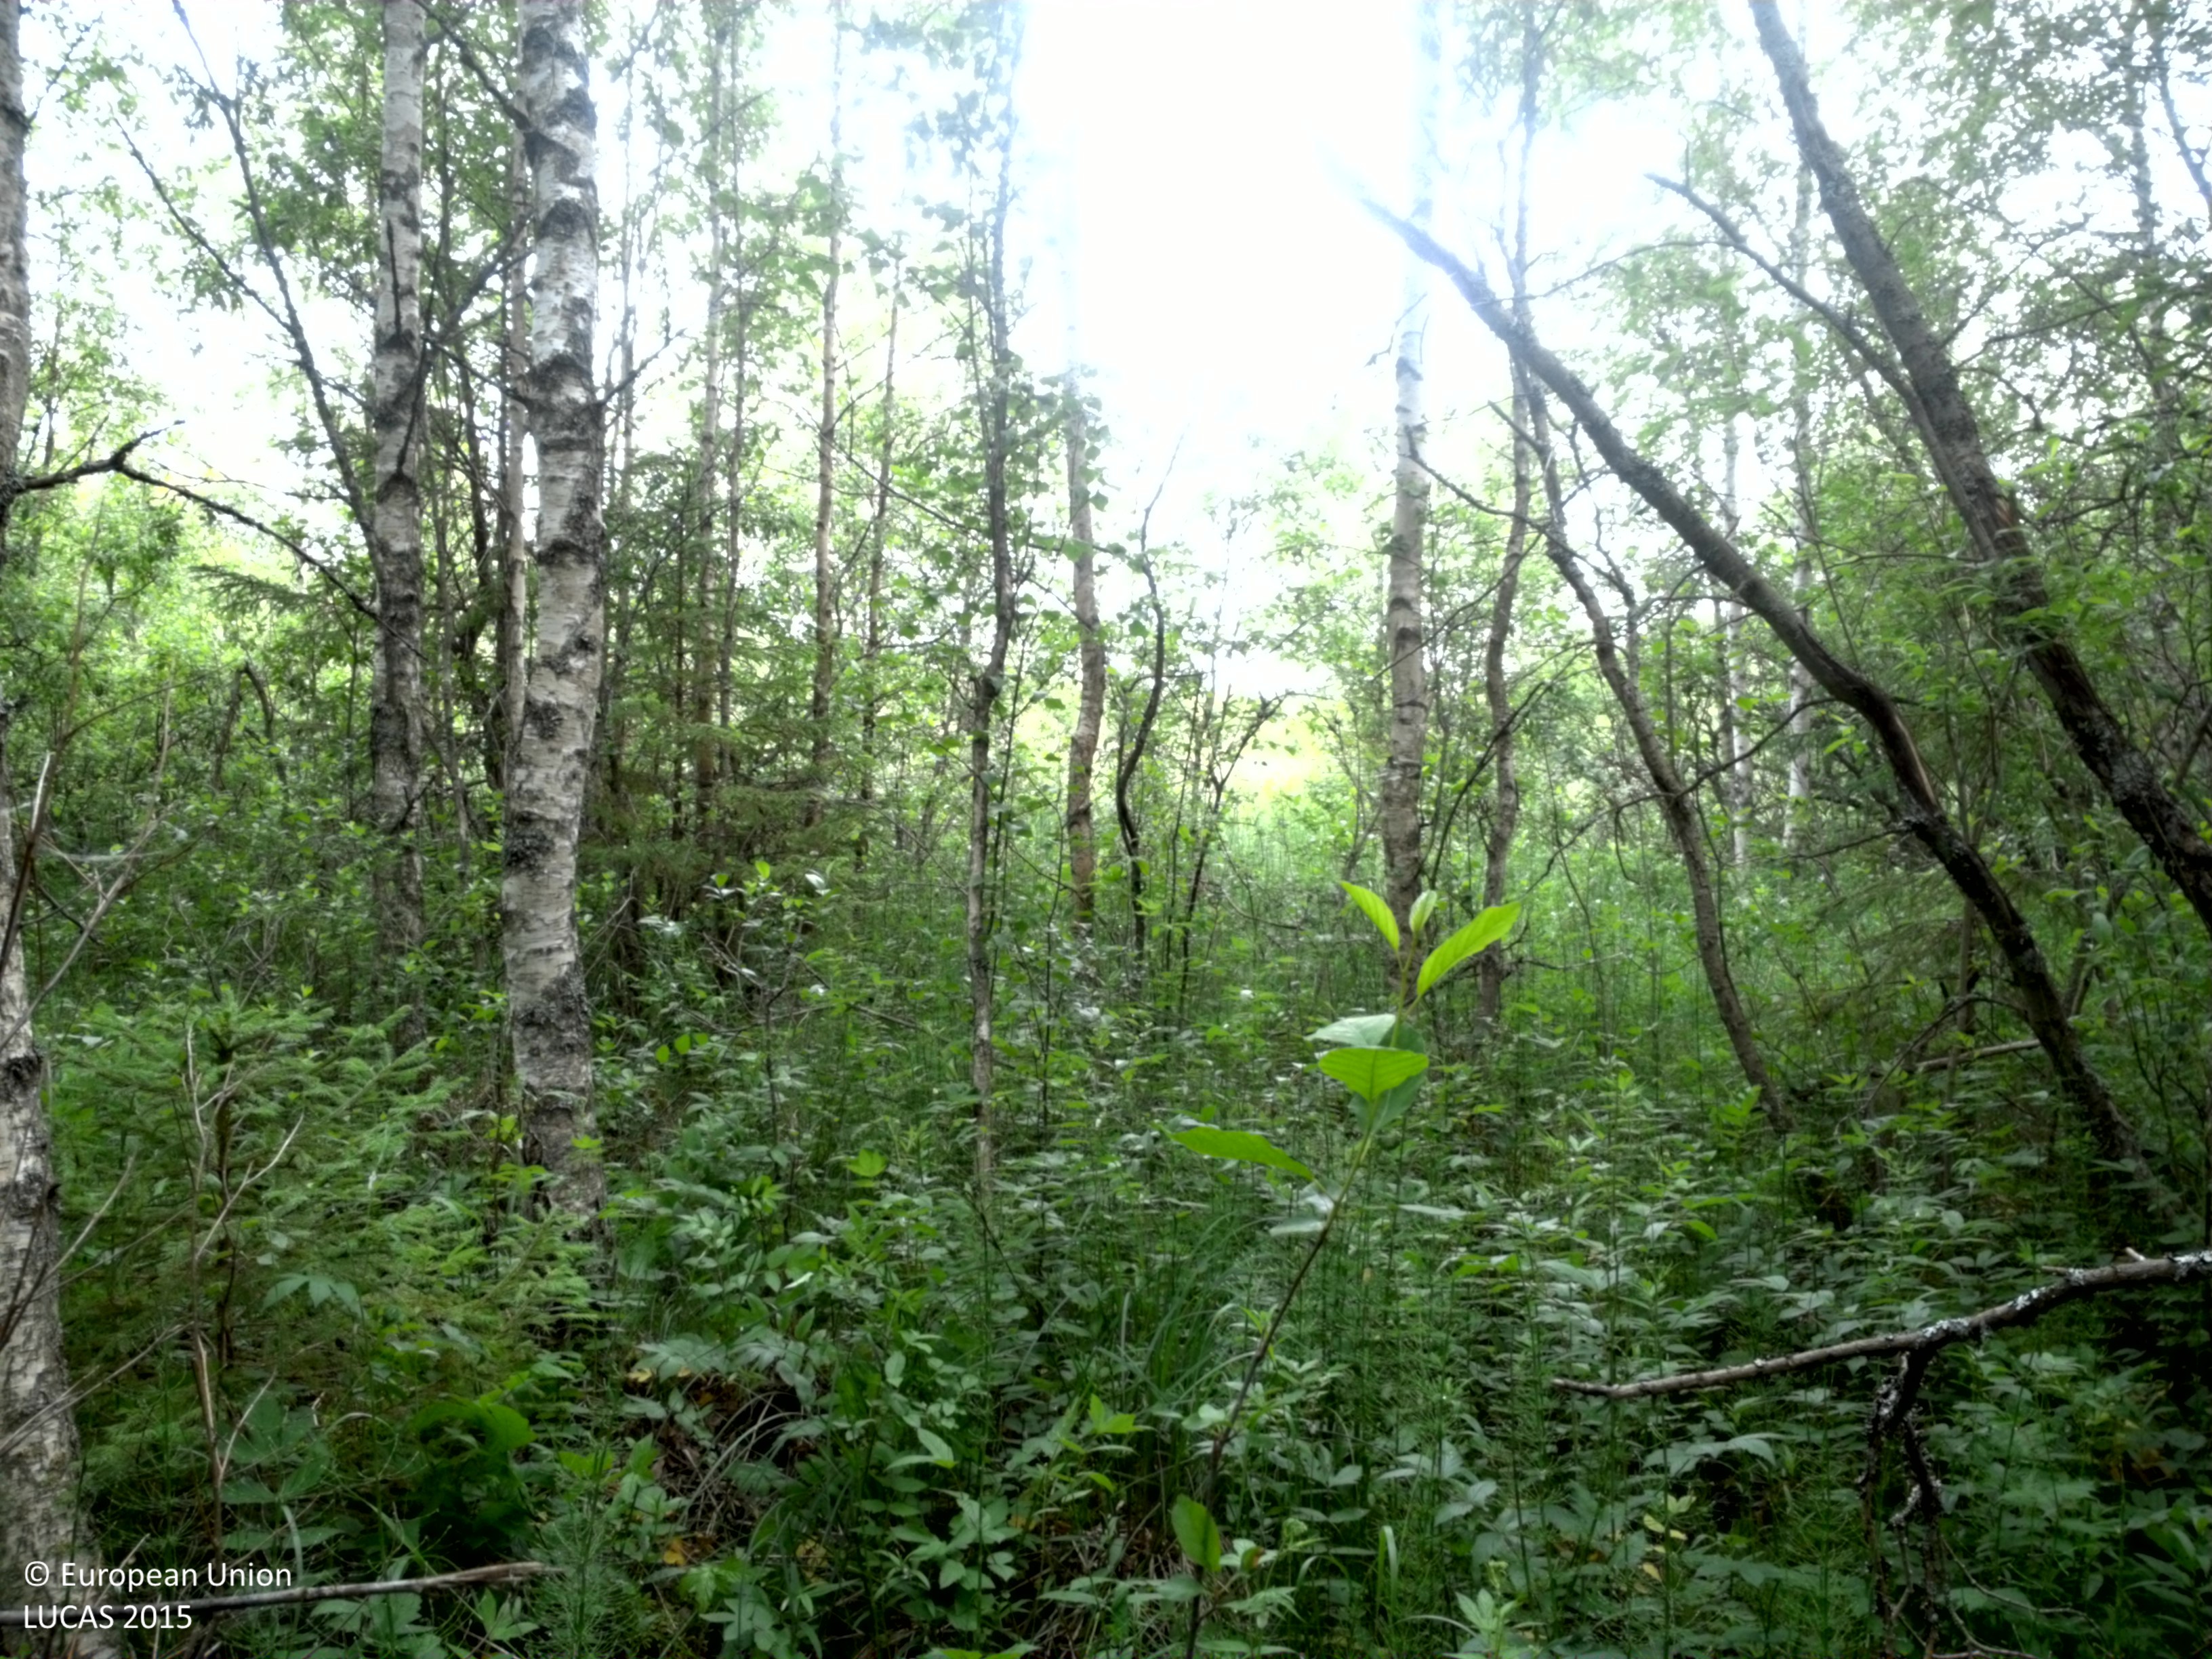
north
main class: Woodland
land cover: Broadleaved woodland
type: hemiboreal forest and nemoral coniferous forest and mixed broadleaved-coniferous forest
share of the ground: > 75 %
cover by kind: broadleaved forest trees 90 %, herbaceous plants 10 %
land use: Forestry
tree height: > 5 m
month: July
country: SE
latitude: 59.9547
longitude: 16.9571
